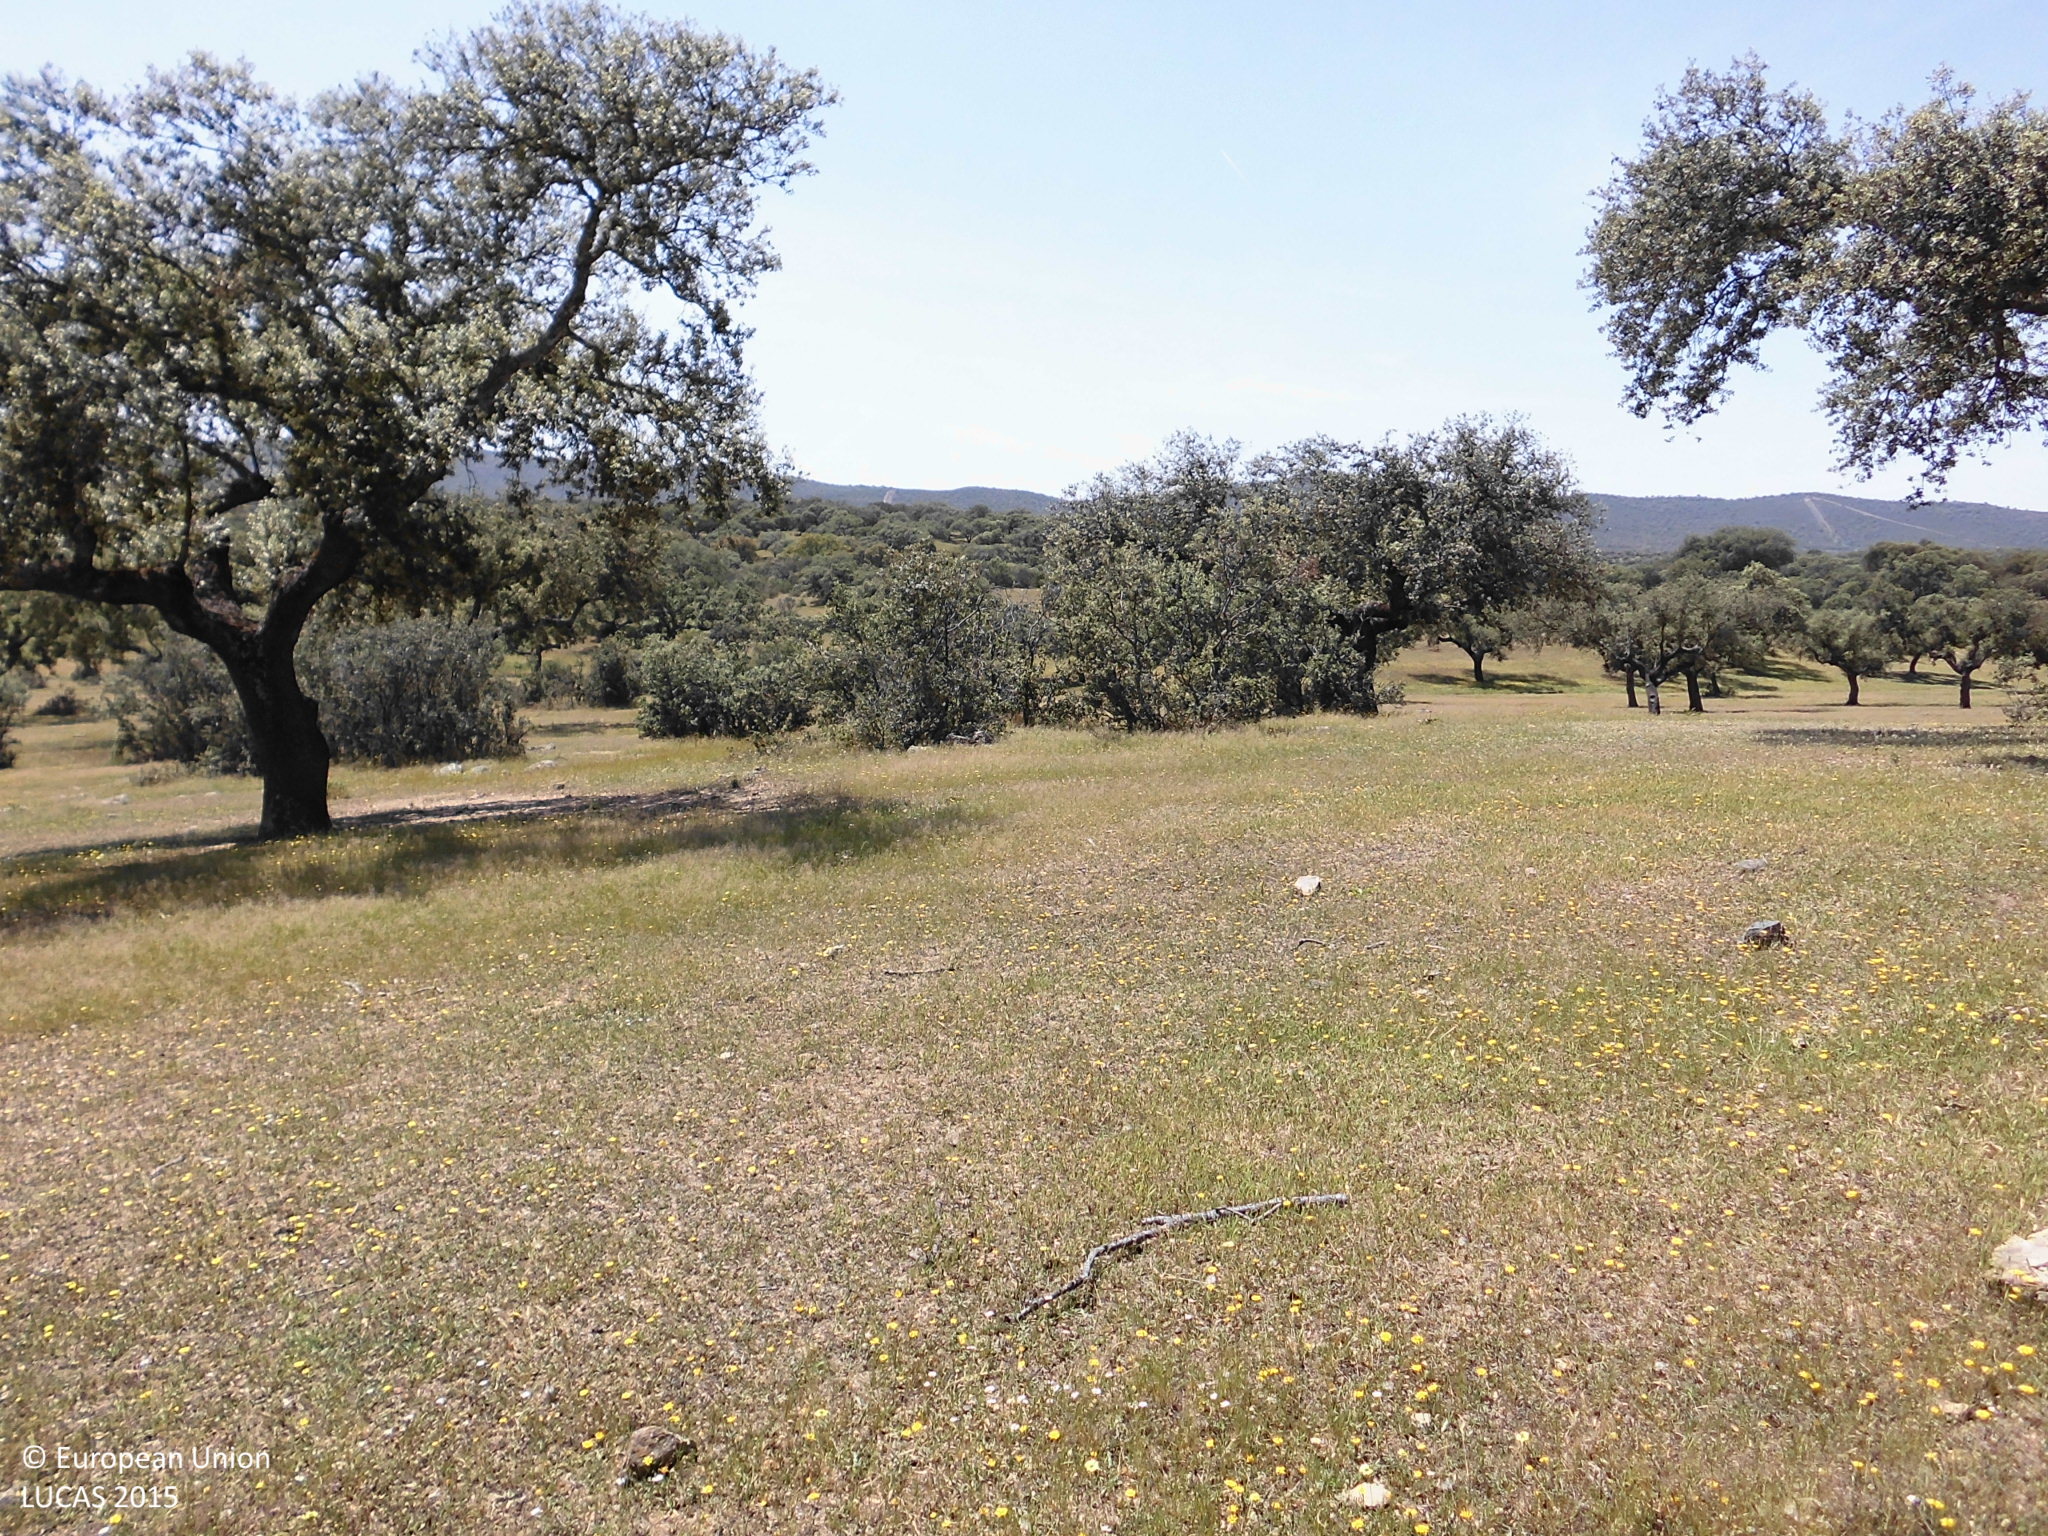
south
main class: Woodland
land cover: Broadleaved woodland
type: broadleaved evergreen forest
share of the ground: 10 - 25 %
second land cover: Grassland without tree/shrub cover
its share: > 75 %
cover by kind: herbaceous plants 85 %, broadleaved forest trees 15 %
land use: Forestry
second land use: Agriculture (excluding fallow land and kitchen gardens)
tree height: > 5 m
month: May
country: ES
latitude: 39.4786
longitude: -7.0676
